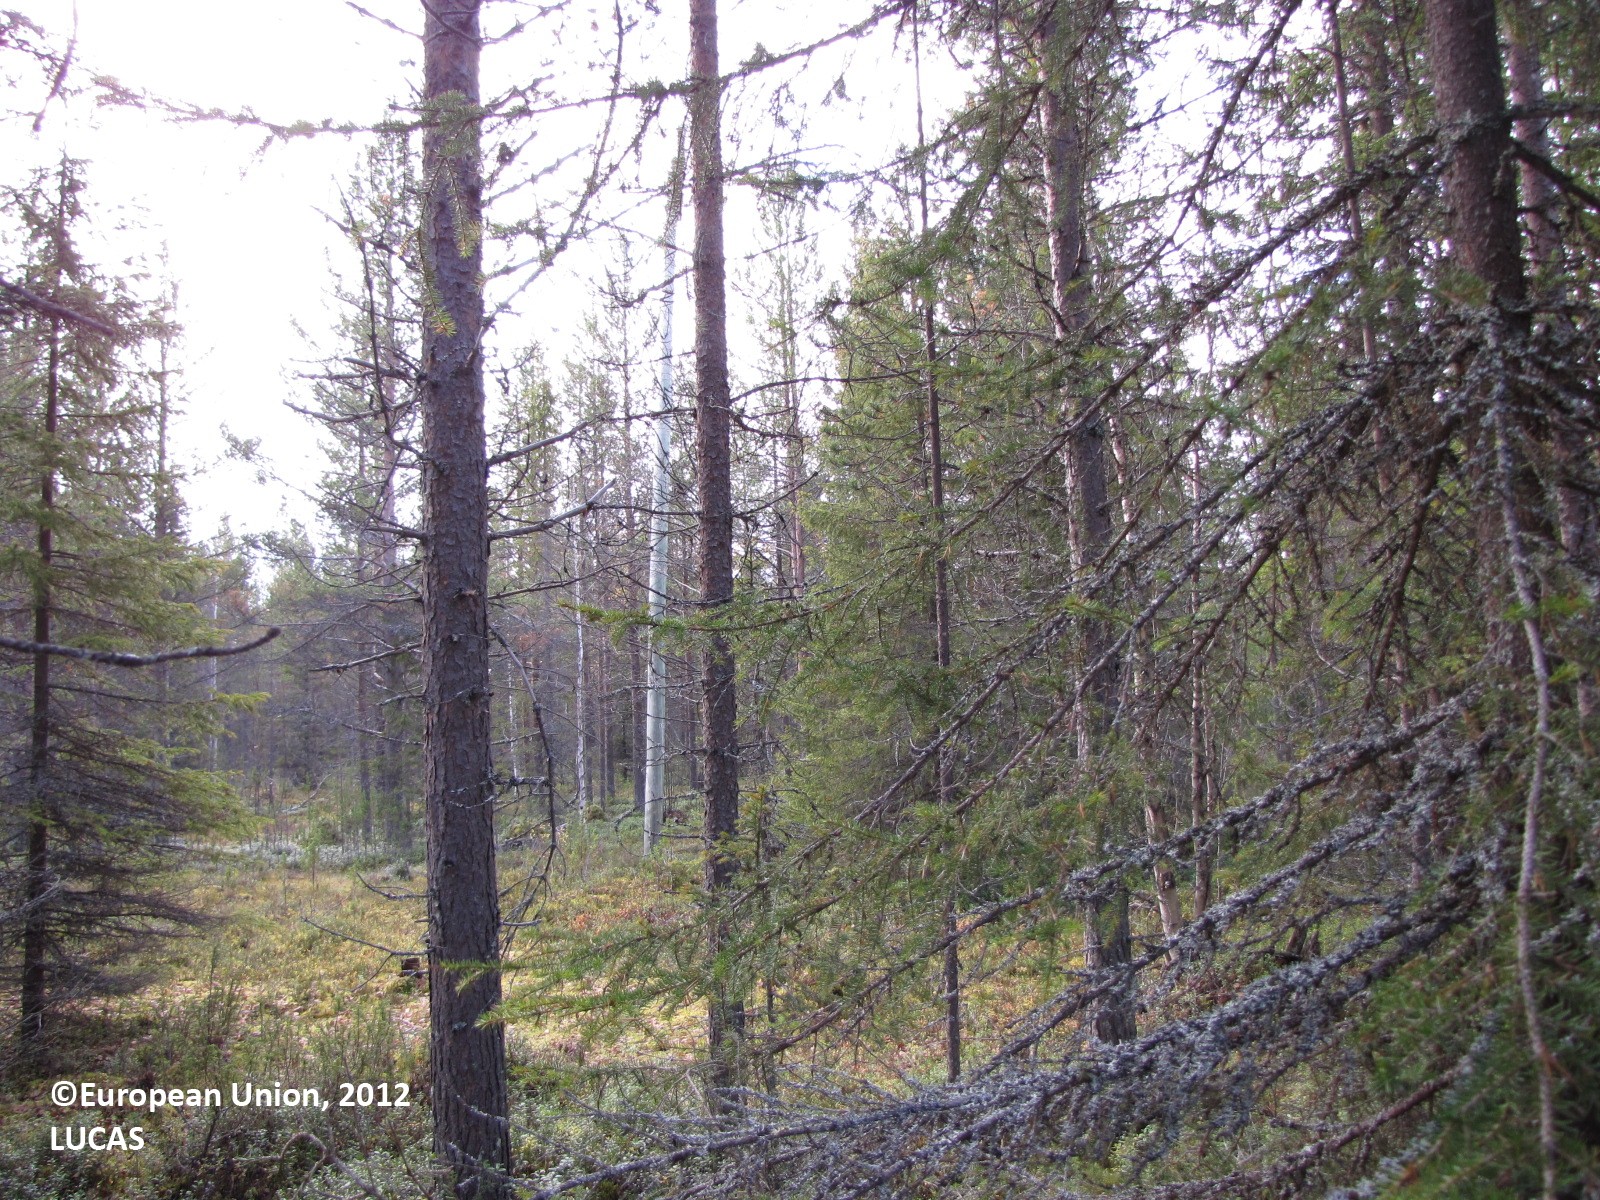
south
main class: Woodland
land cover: Pine dominated coniferous woodland
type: boreal forest
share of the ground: 25 - 50 %
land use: Forestry
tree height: > 5 m
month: September
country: FI
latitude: 67.7322
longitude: 25.1978
